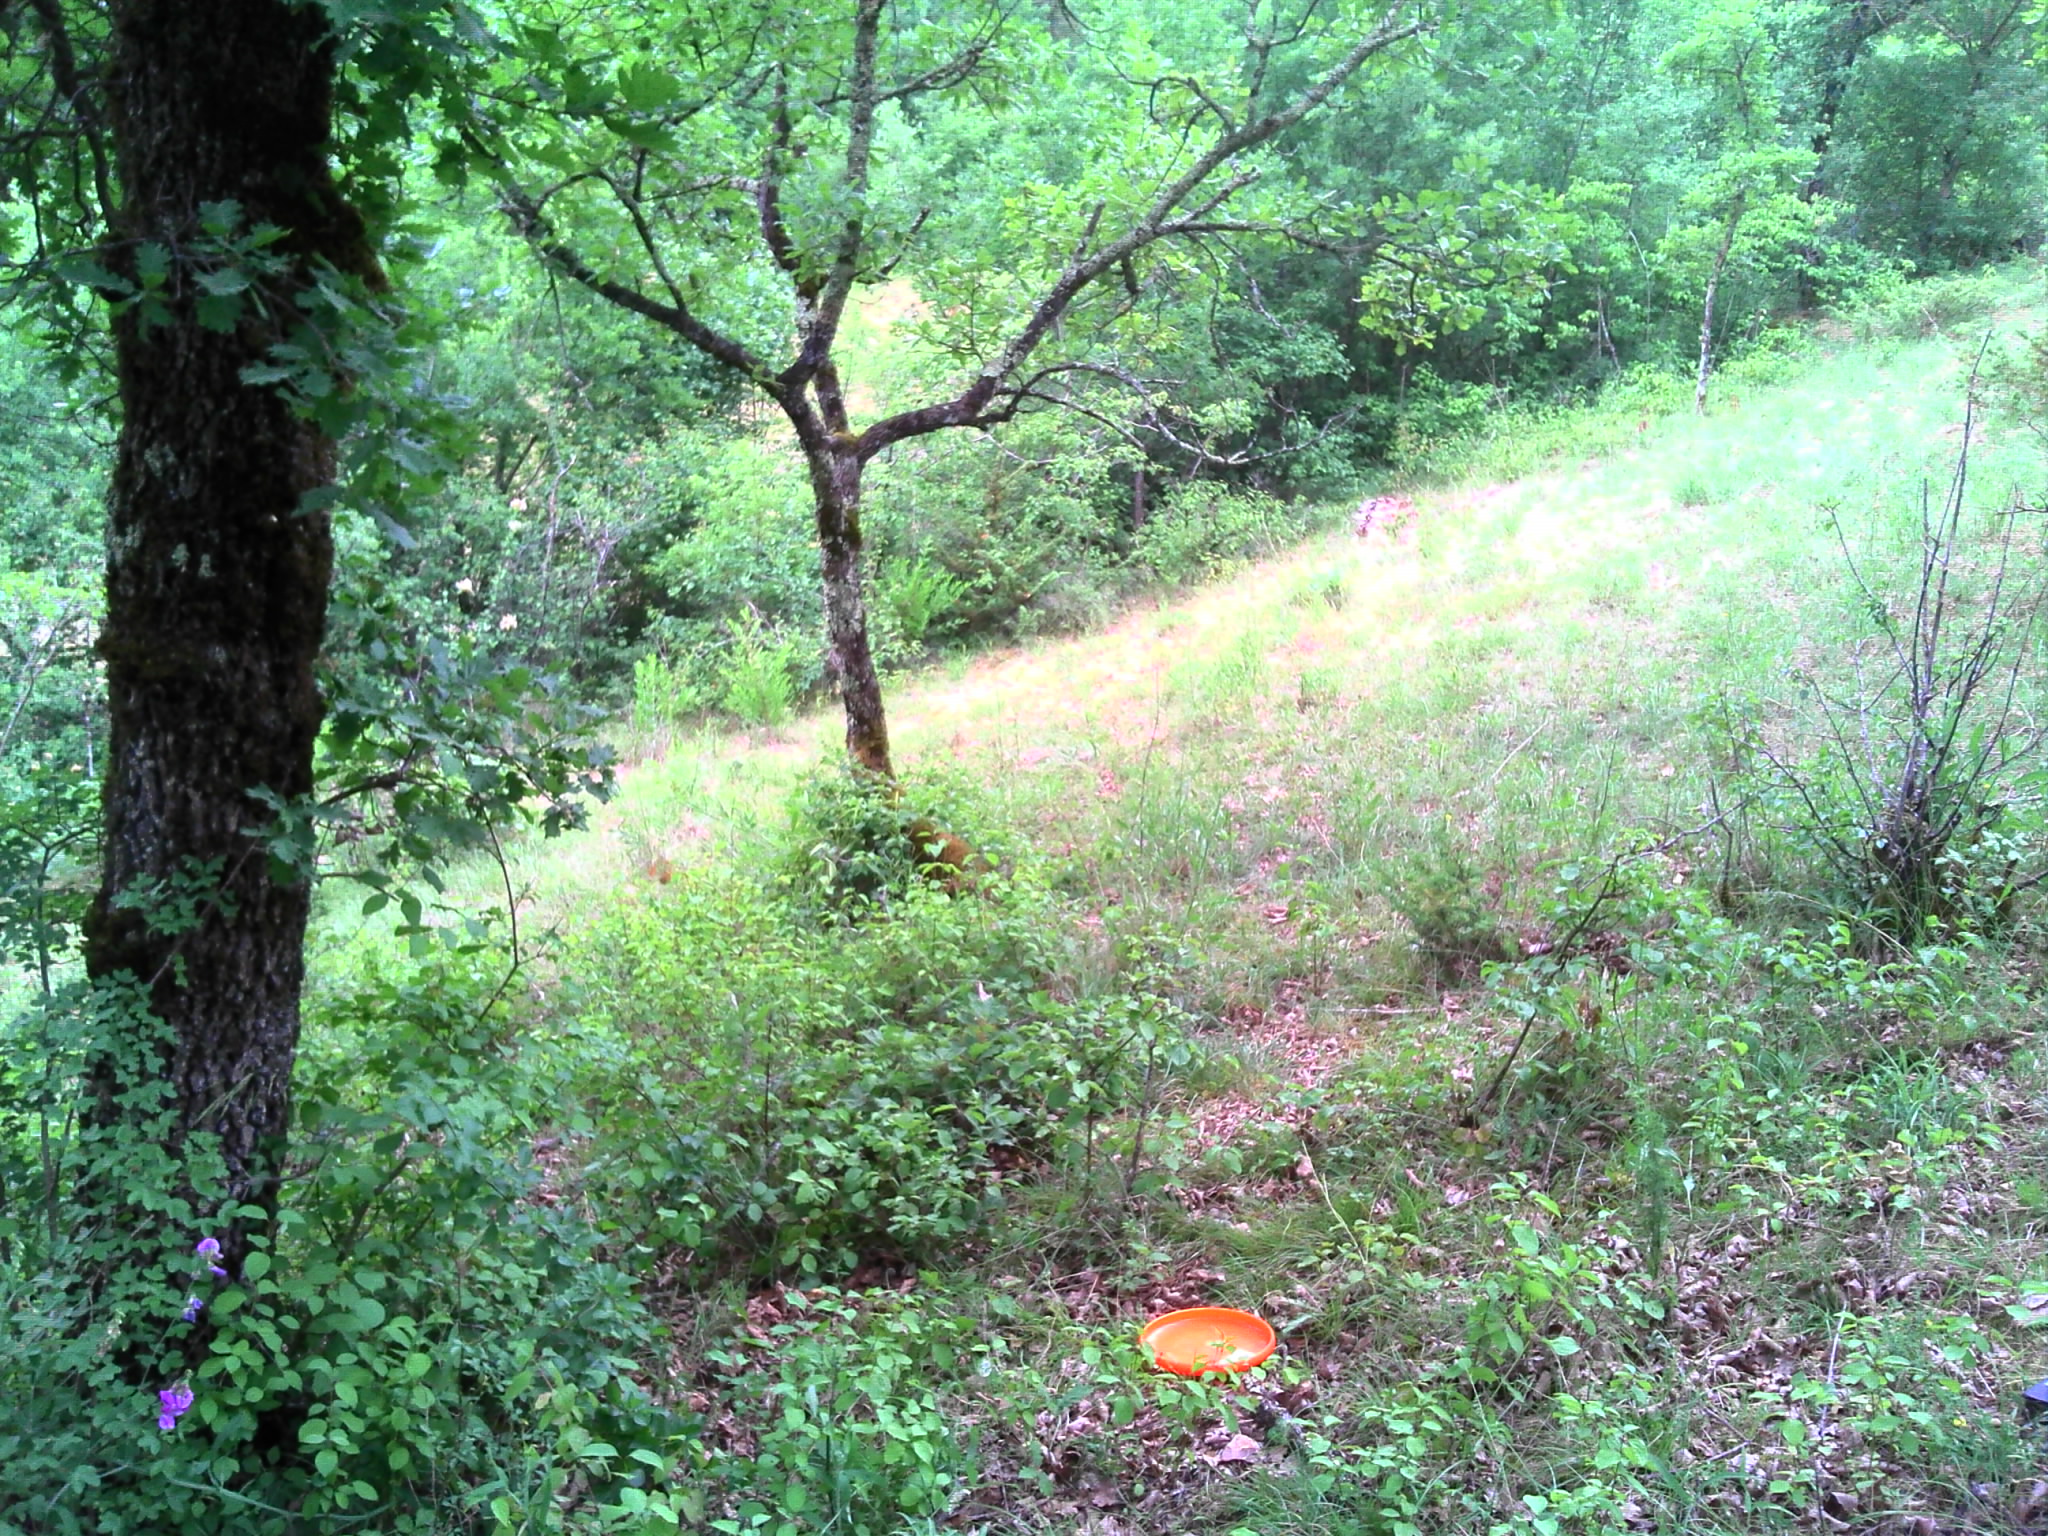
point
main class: Woodland
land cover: Broadleaved woodland
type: thermophilous deciduous forest
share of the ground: 50 - 75 %
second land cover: Grassland without tree/shrub cover
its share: 25 - 50 %
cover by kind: broadleaved forest trees 80 %, herbaceous plants 20 %
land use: Forestry
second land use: Agriculture (excluding fallow land and kitchen gardens)
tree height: > 5 m
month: June
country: FR
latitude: 44.4280
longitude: 1.8478
